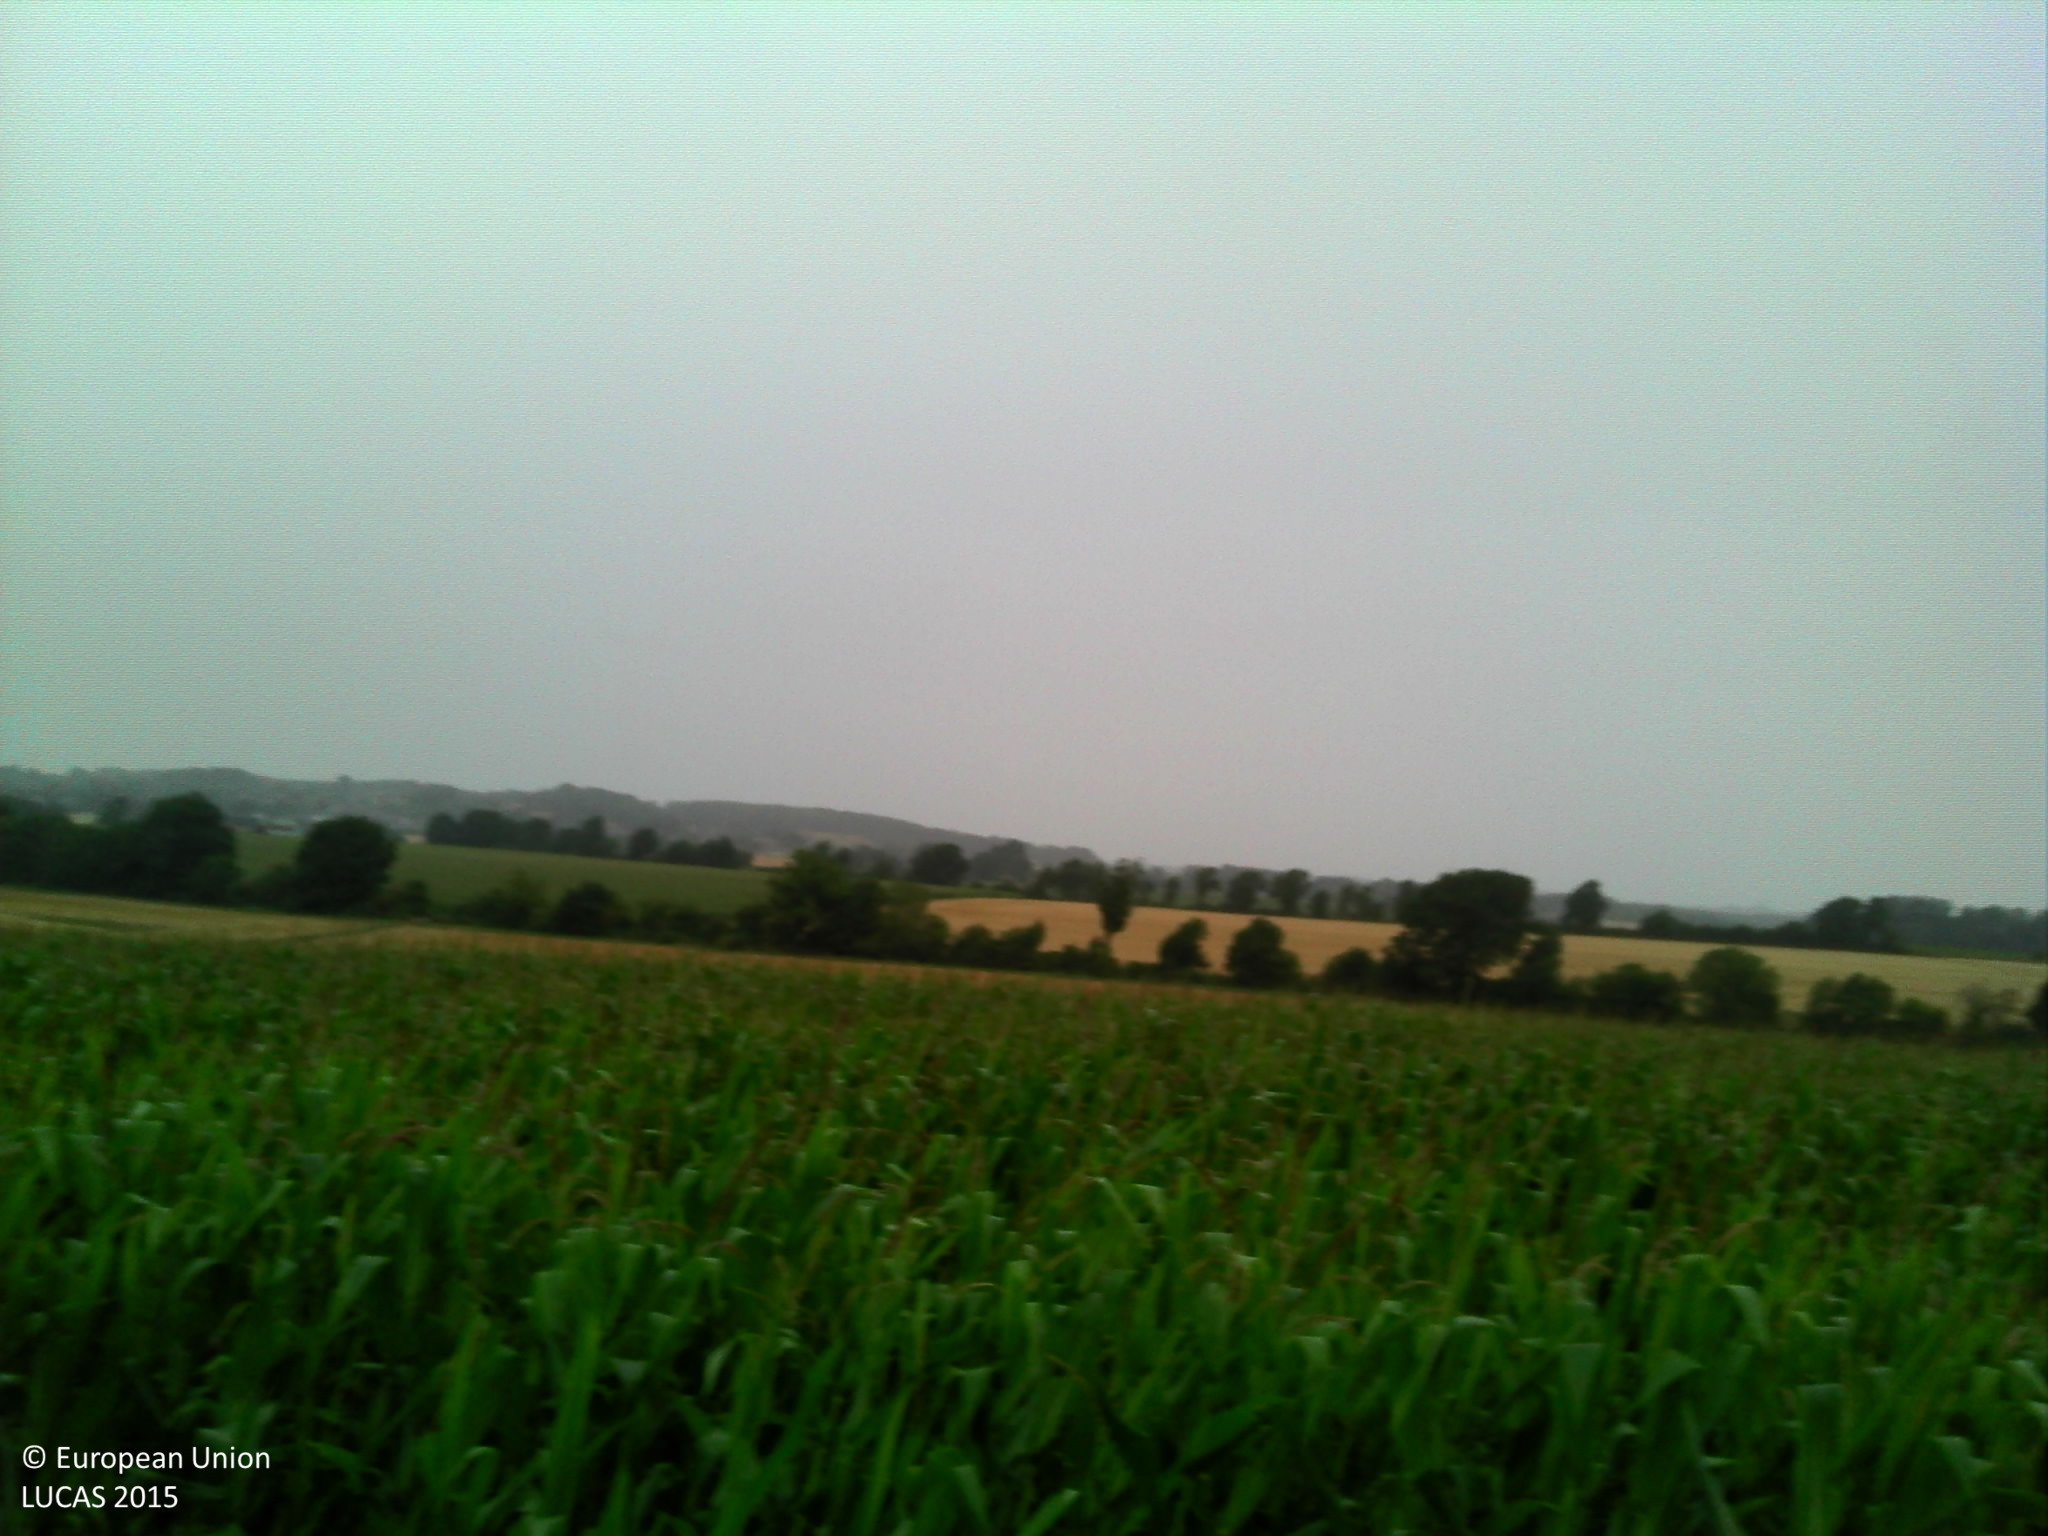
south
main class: Cropland
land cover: Maize
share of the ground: > 75 %
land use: Agriculture (excluding fallow land and kitchen gardens)
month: July
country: FR
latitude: 48.0053
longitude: 0.6353
